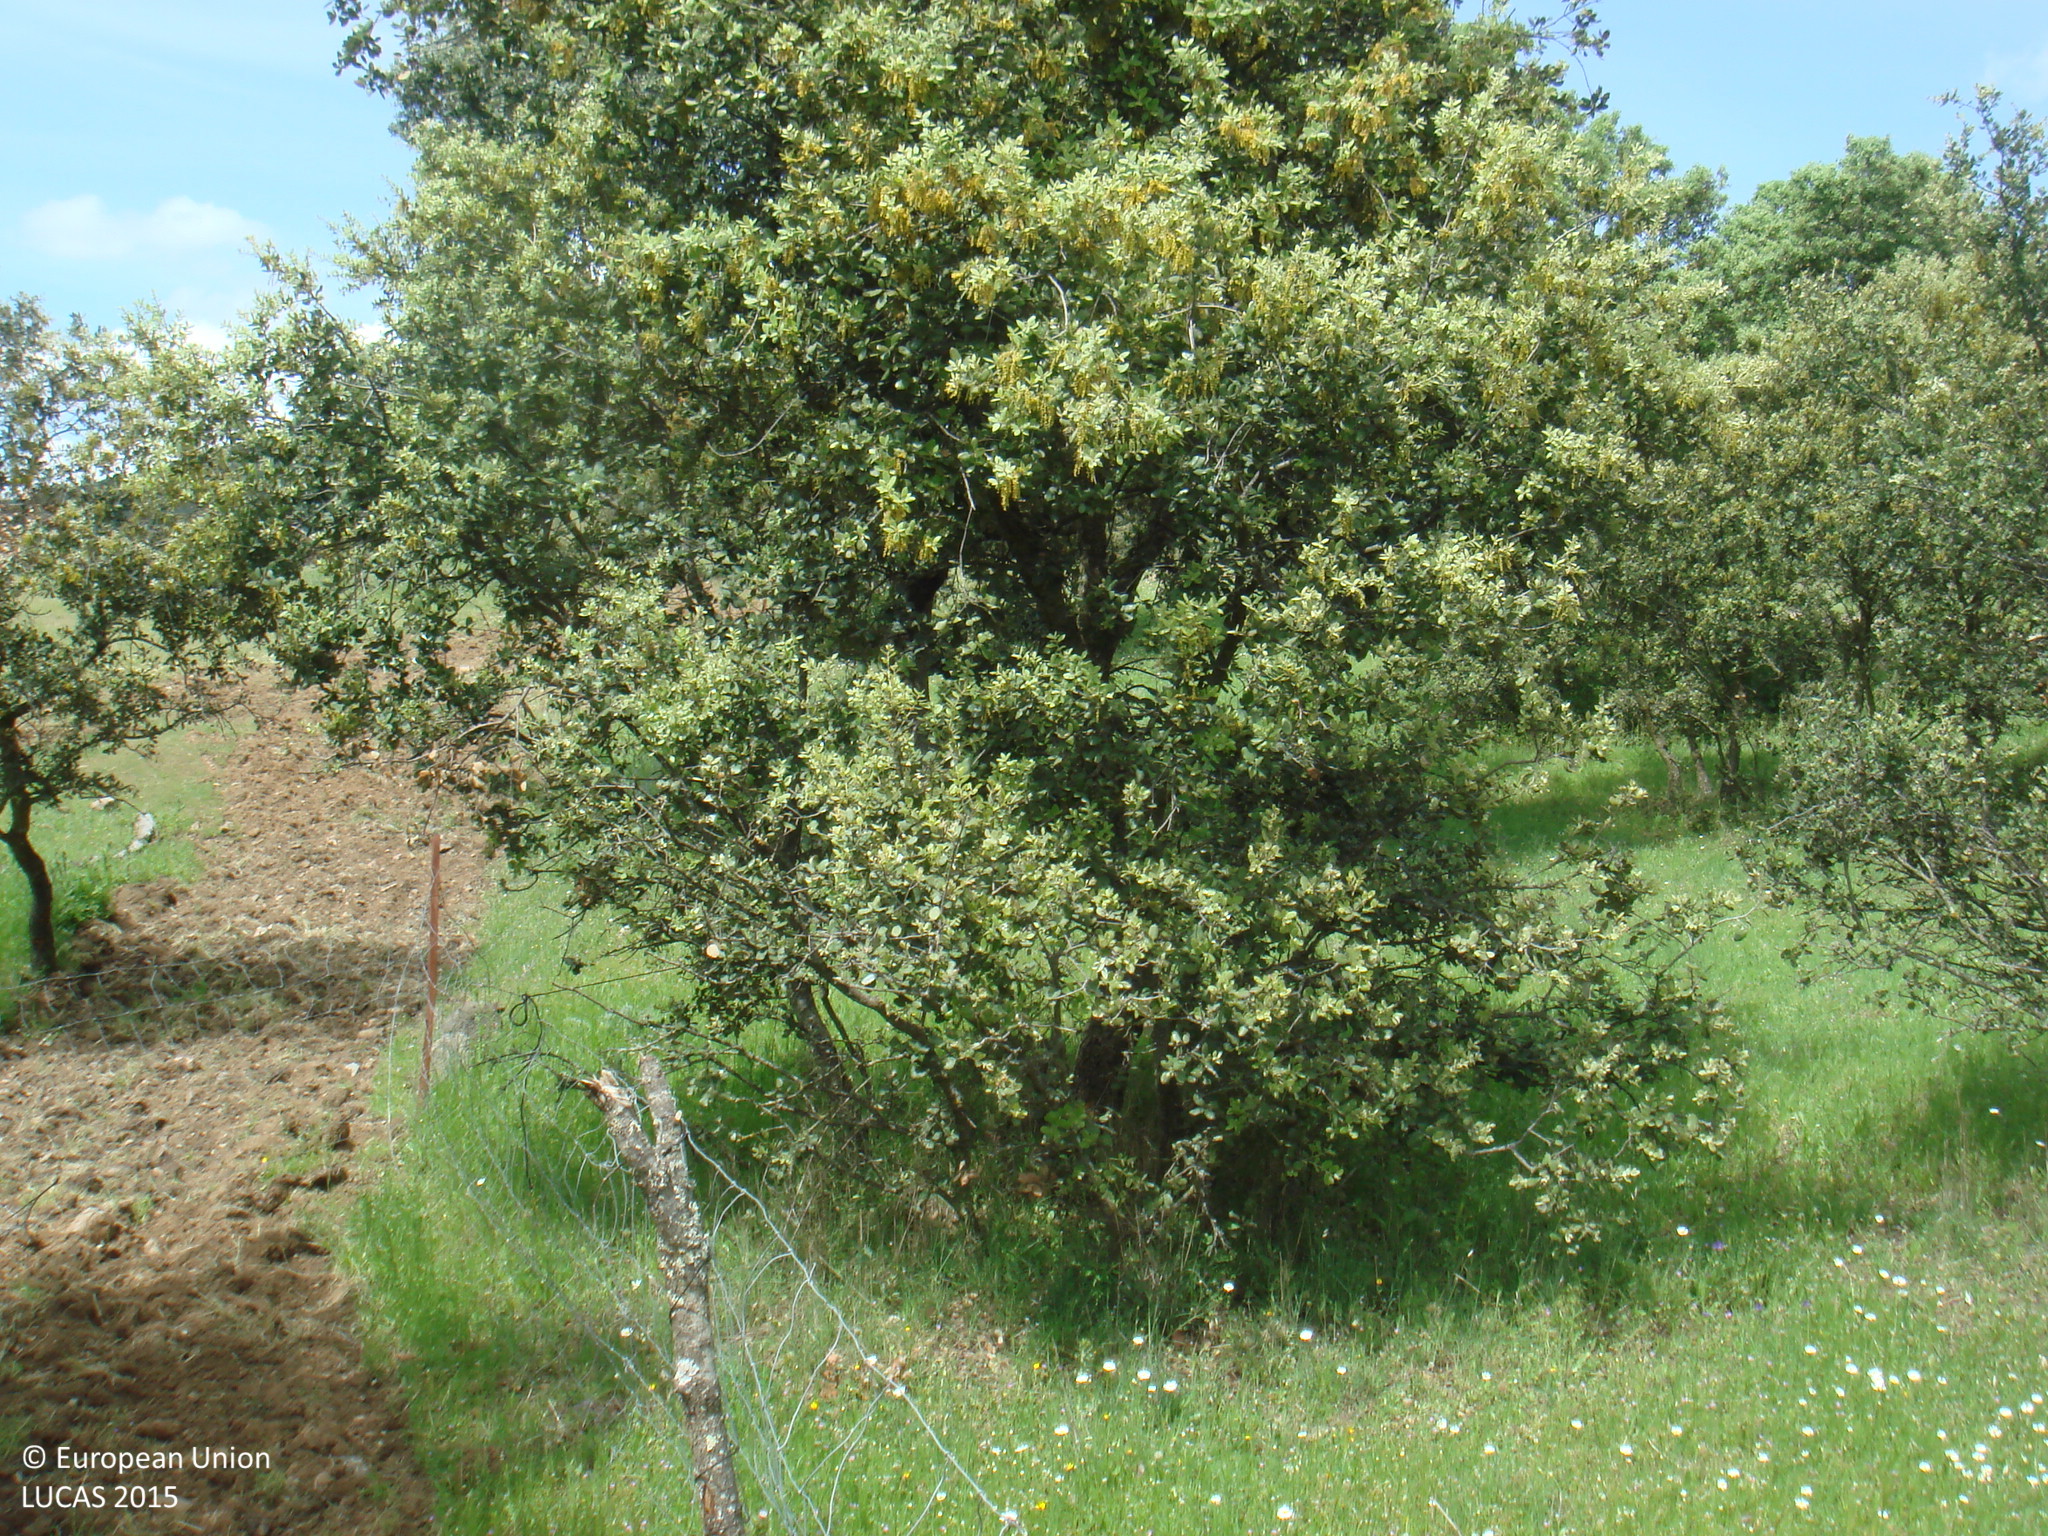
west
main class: Woodland
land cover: Broadleaved woodland
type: broadleaved evergreen forest
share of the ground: 25 - 50 %
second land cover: Grassland without tree/shrub cover
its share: 50 - 75 %
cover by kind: herbaceous plants 55 %, broadleaved forest trees 40 %, shrubs 5 %
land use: Forestry
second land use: Agriculture (excluding fallow land and kitchen gardens)
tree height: > 5 m
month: April
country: ES
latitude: 38.2497
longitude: -5.0738
